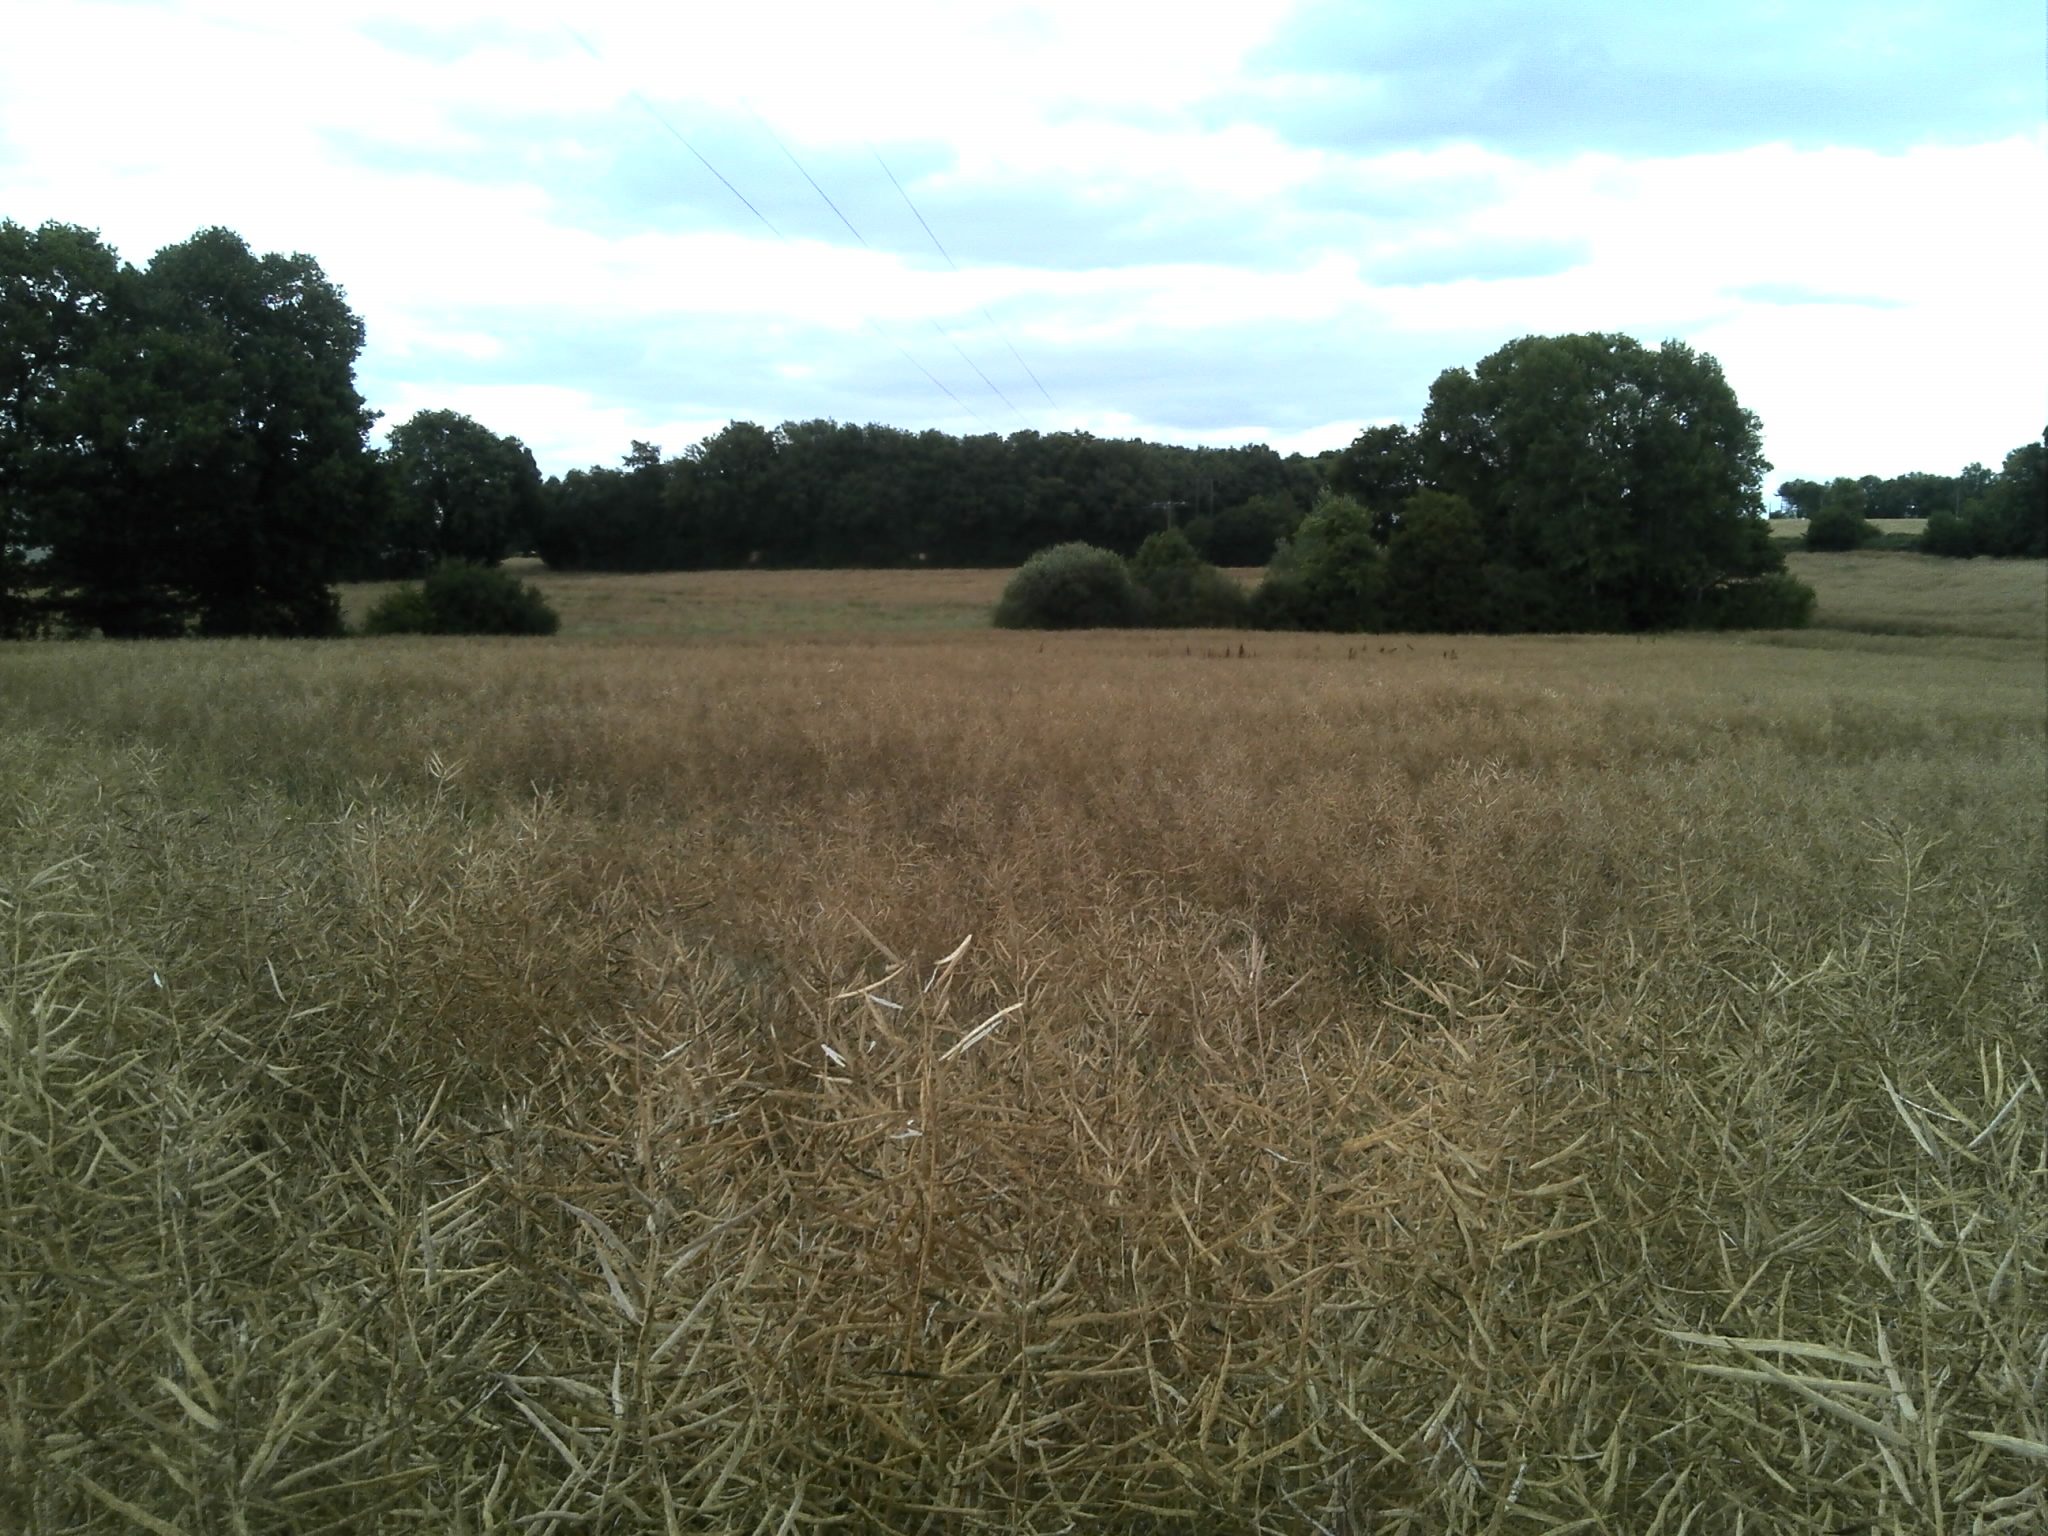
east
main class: Cropland
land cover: Rape and turnip rape
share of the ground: > 75 %
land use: Agriculture (excluding fallow land and kitchen gardens)
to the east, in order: Rape and turnip rape; Electric lines; Rape and turnip rape; Ditches and canals; Abandoned hedges; Rape and turnip rape
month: July
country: FR
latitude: 46.9211
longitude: 1.0951
